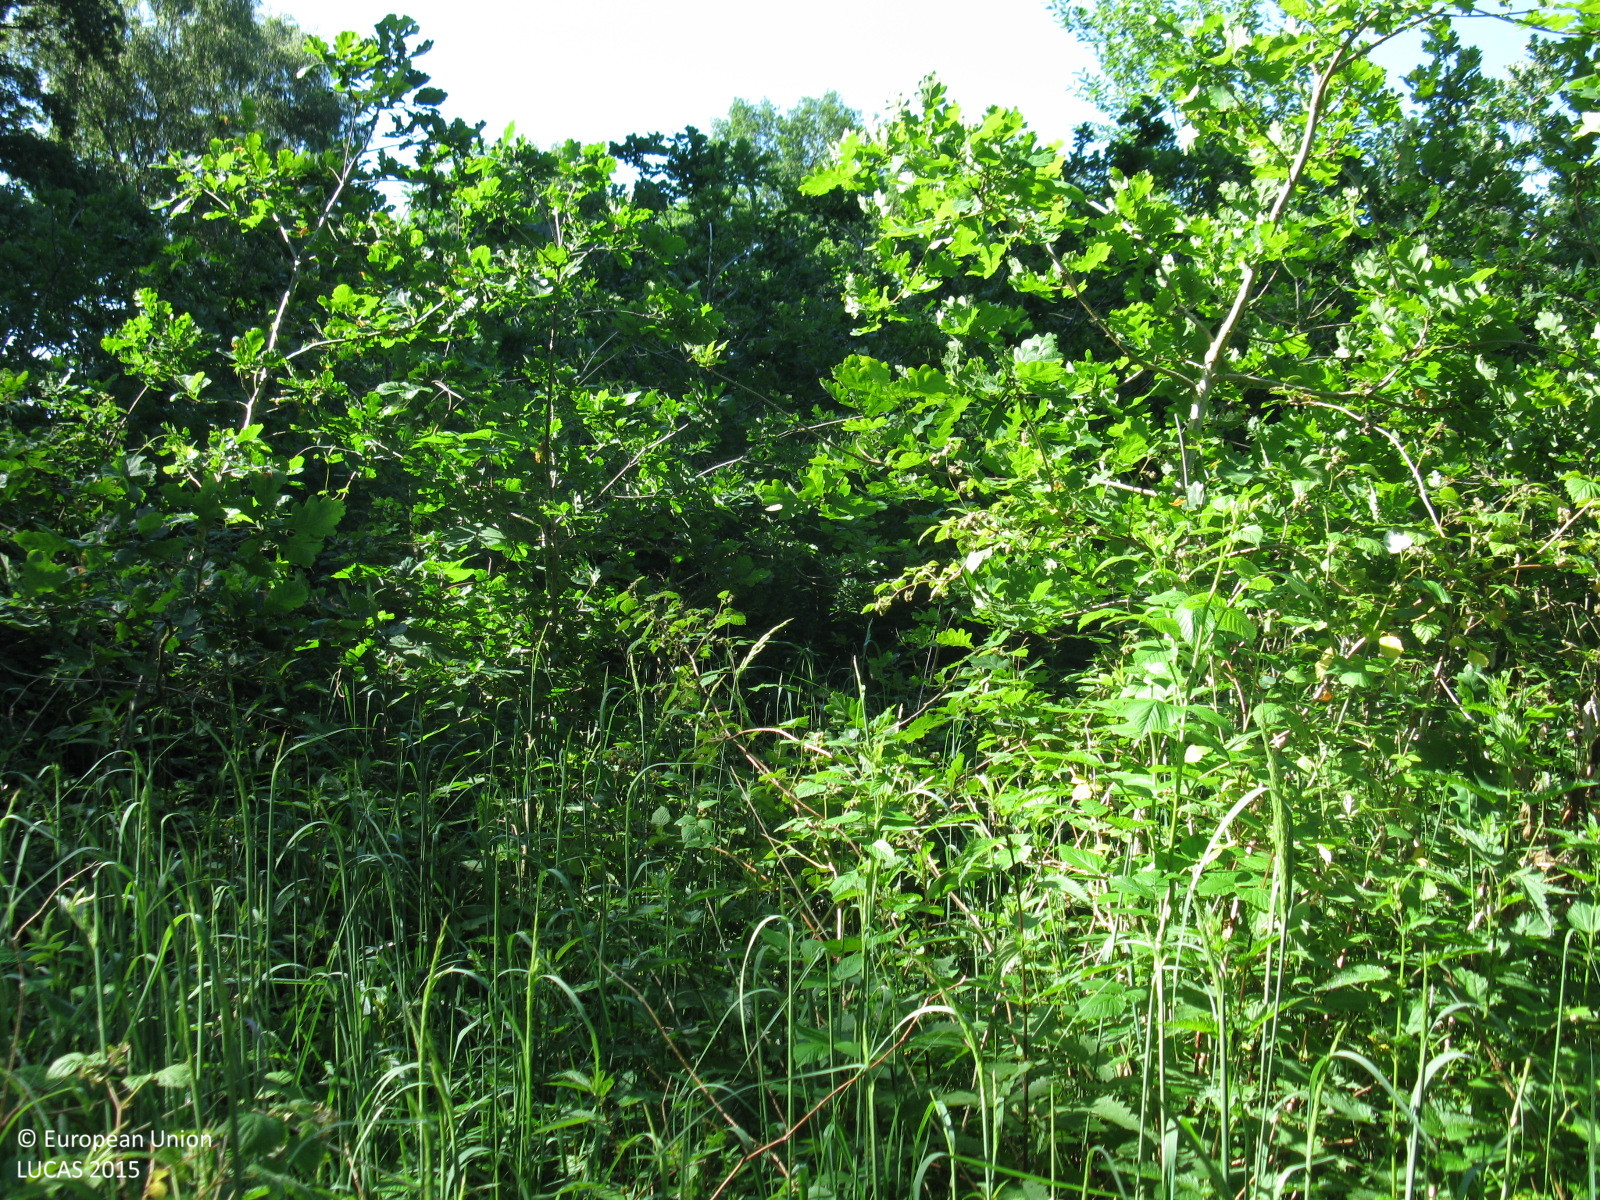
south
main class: Woodland
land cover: Broadleaved woodland
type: mesophytic deciduous forest
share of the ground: > 75 %
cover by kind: broadleaved forest trees 90 %, herbaceous plants 10 %
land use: Forestry
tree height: < 5 m
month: June
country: DE
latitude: 52.8530
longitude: 8.4710
